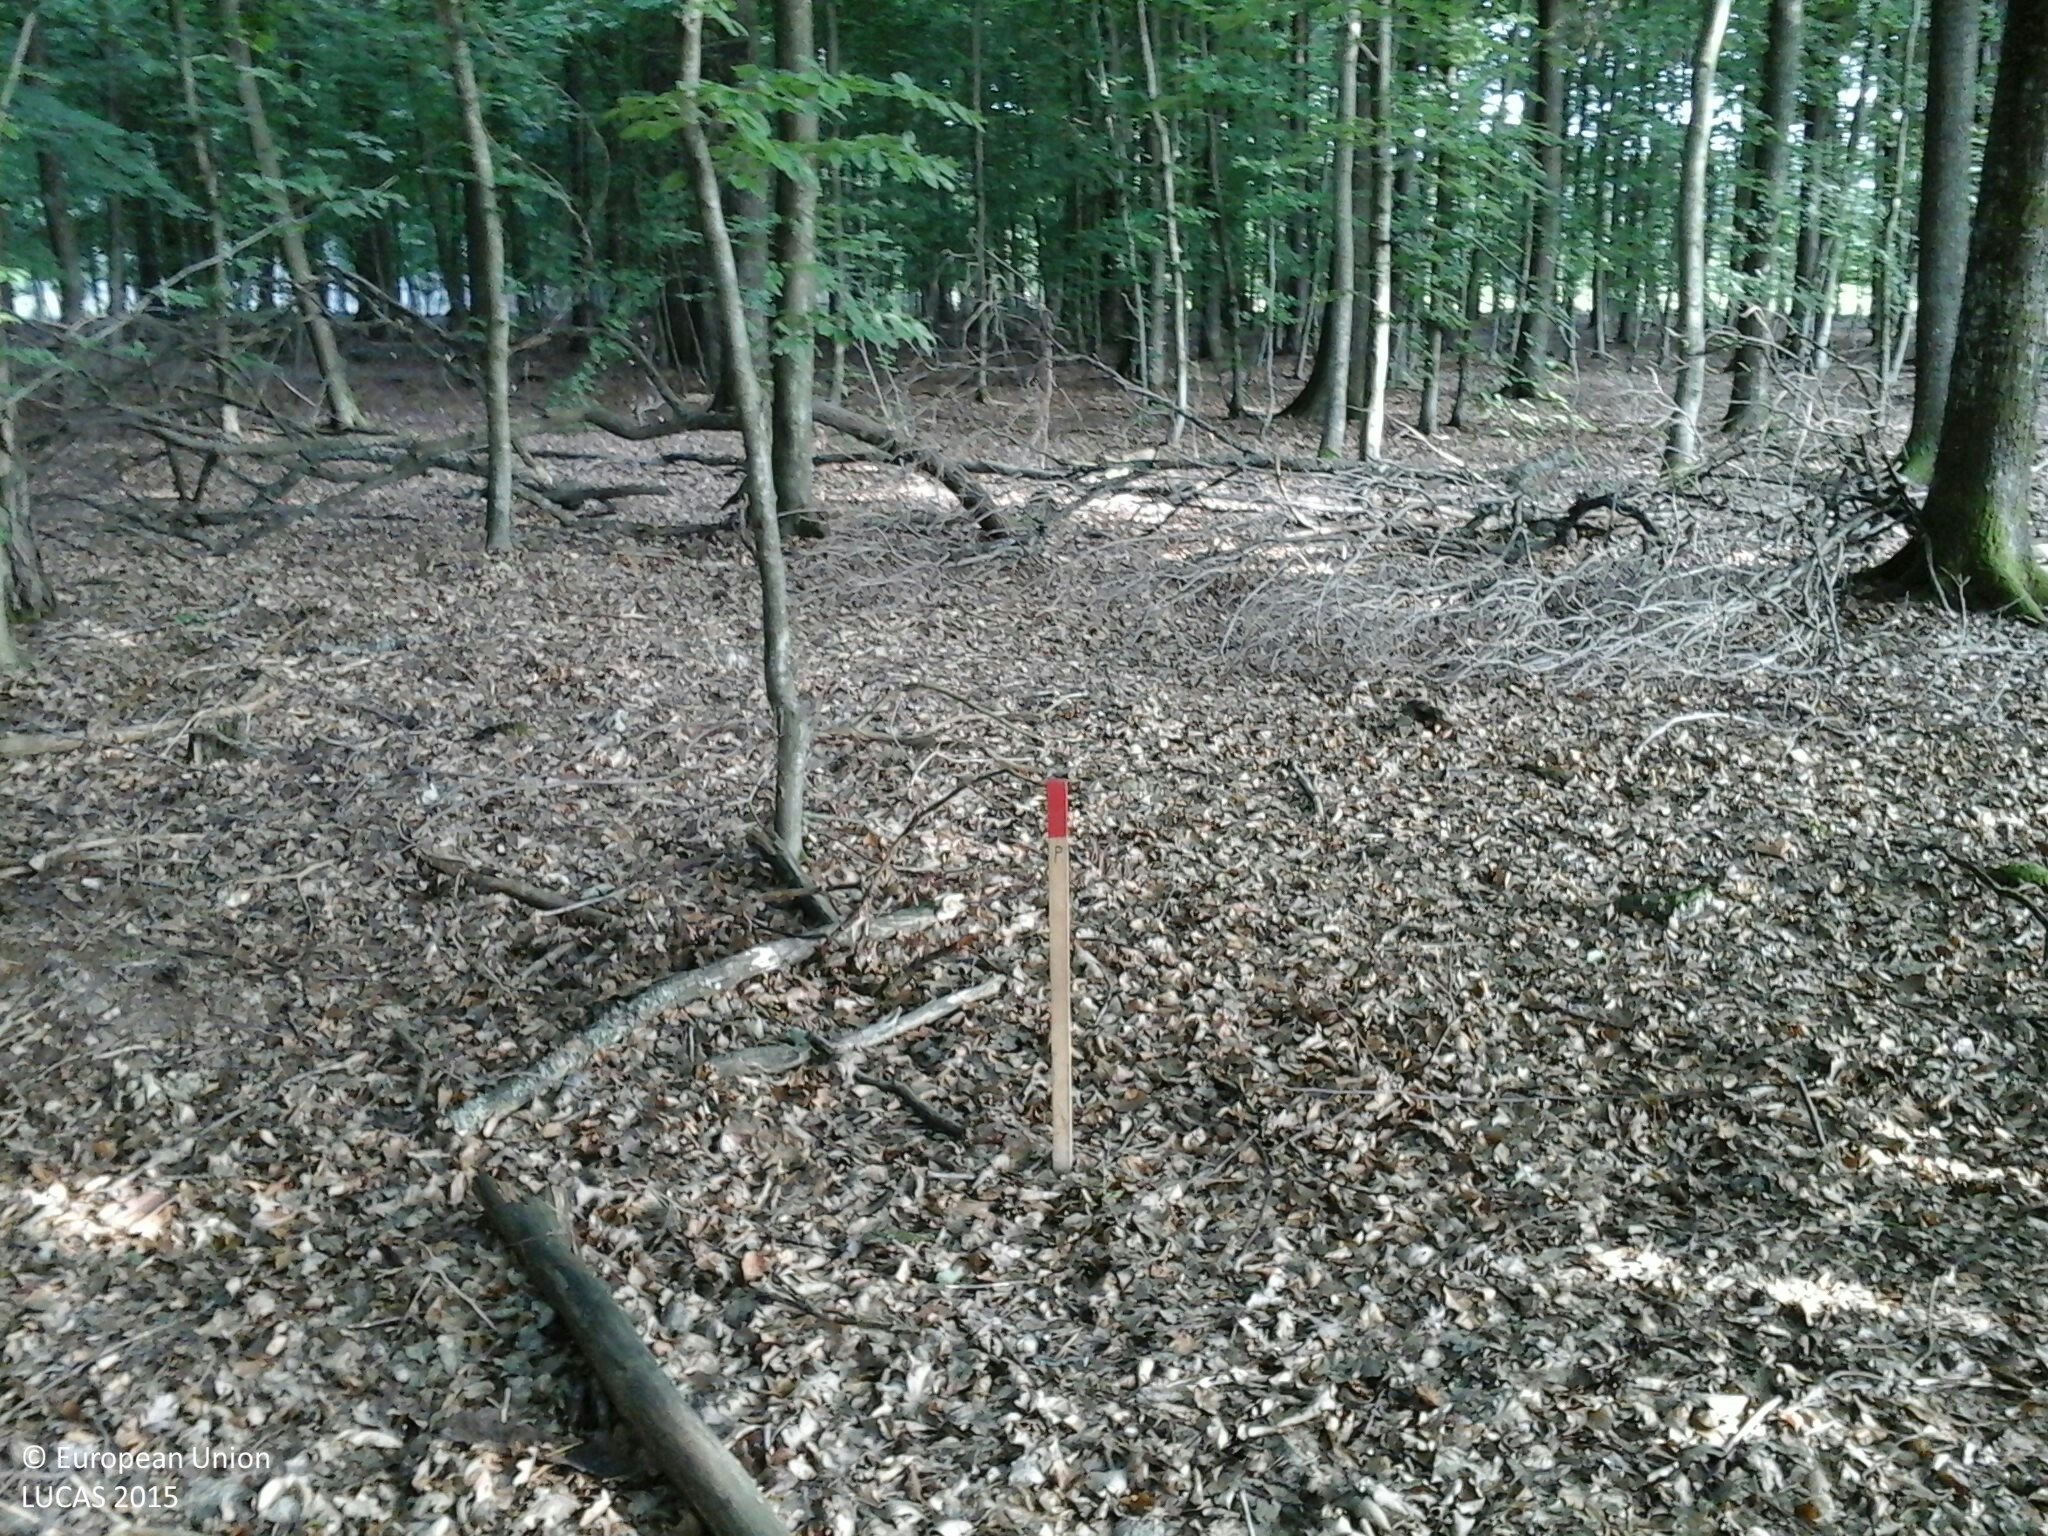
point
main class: Woodland
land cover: Broadleaved woodland
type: mesophytic deciduous forest
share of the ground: > 75 %
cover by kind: broadleaved forest trees 70 %, coniferous forest trees 20 %, shrubs 5 %, herbaceous plants 5 %
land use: Forestry
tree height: > 5 m
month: July
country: HU
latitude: 46.8794
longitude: 16.4447
